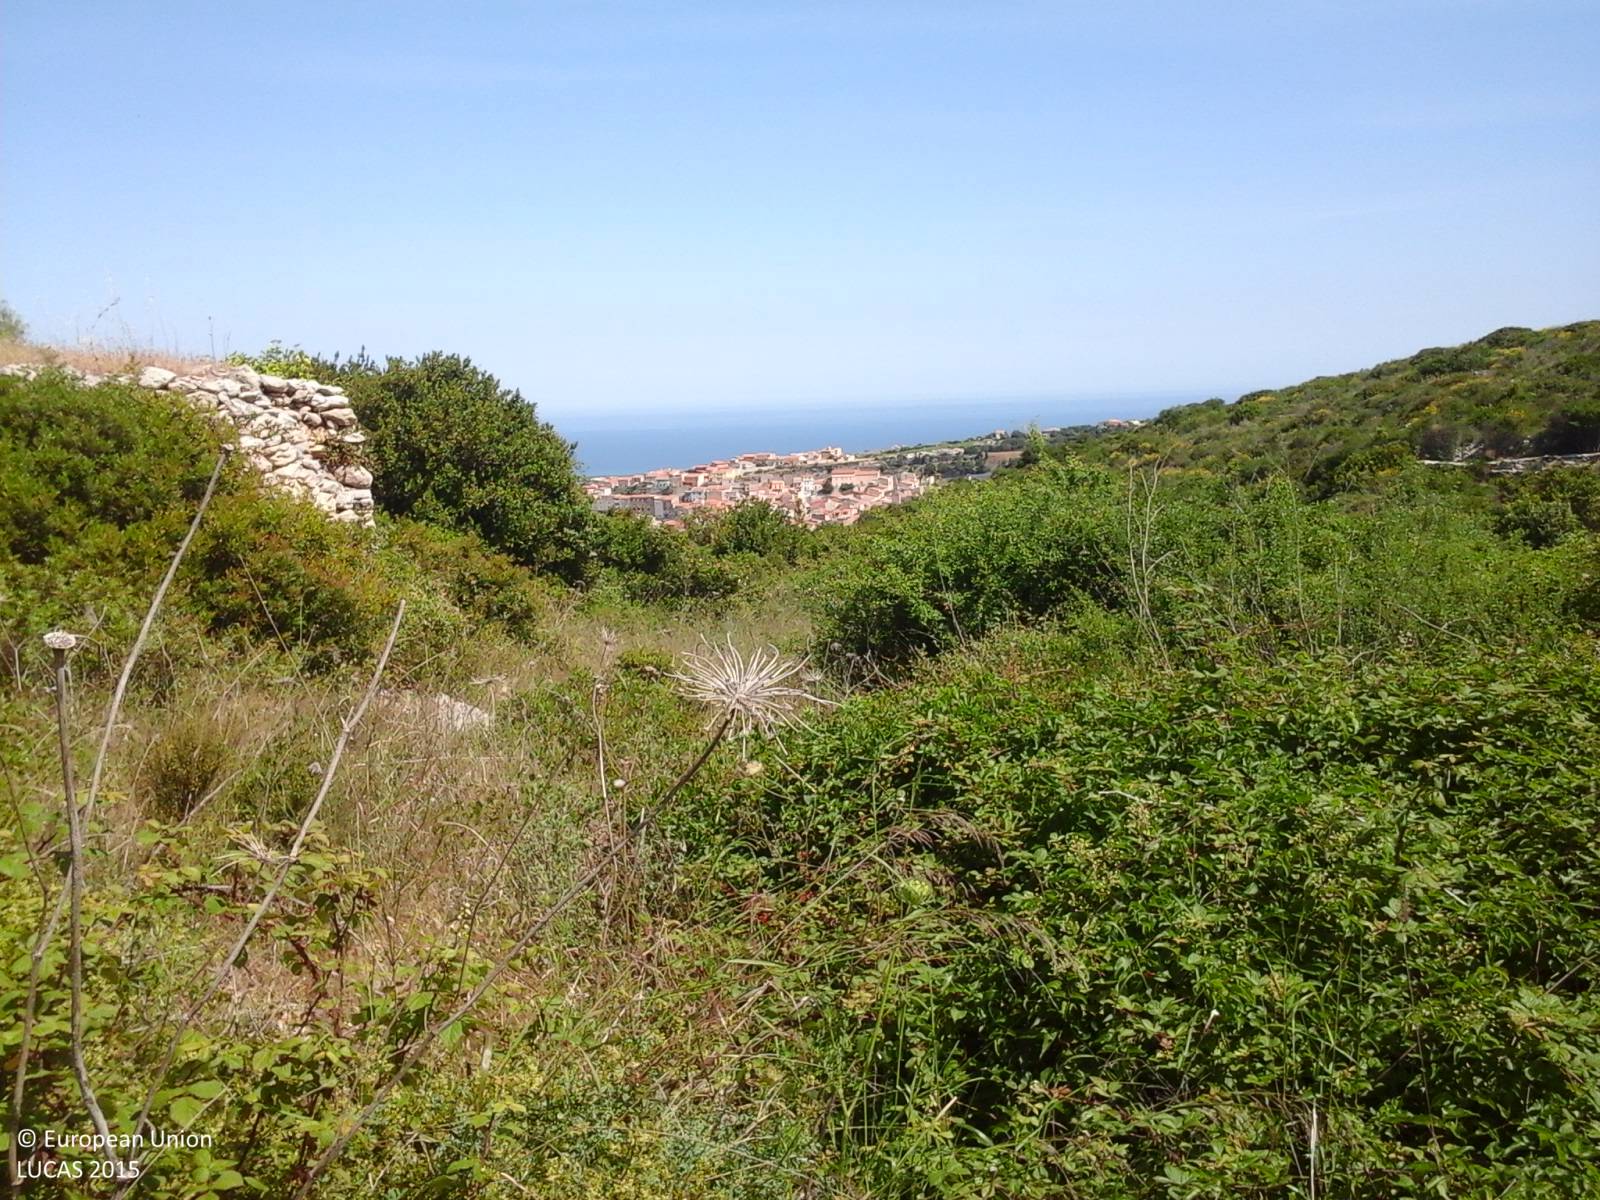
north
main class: Shrubland
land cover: Shrubland without tree cover
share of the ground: > 75 %
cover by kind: herbaceous plants 55 %, shrubs 45 %
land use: Semi-natural and natural areas not in use
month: May
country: IT
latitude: 40.7822
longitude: 8.5966
